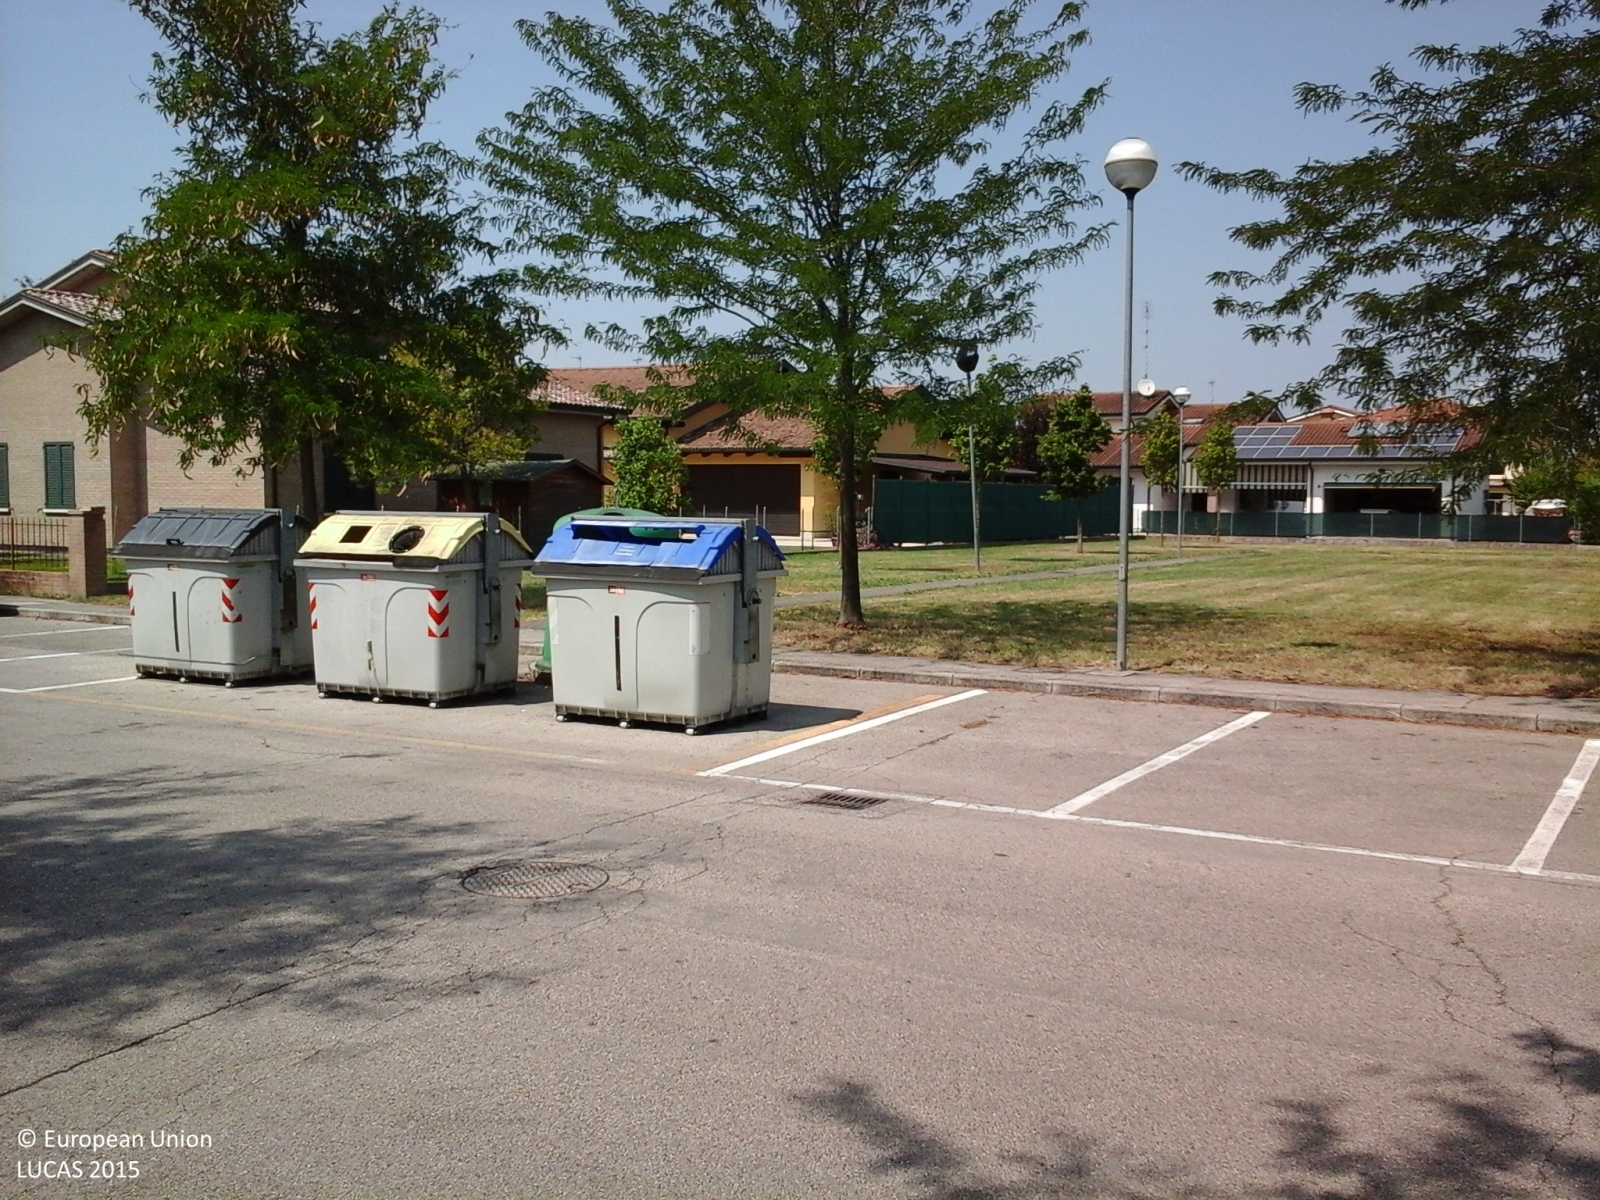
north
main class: Grassland
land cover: Grassland with sparse tree/shrub cover
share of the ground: > 75 %
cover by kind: herbaceous plants 95 %, broadleaved forest trees 5 %
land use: Residential
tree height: > 5 m
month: July
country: IT
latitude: 44.6621
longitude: 11.6488
